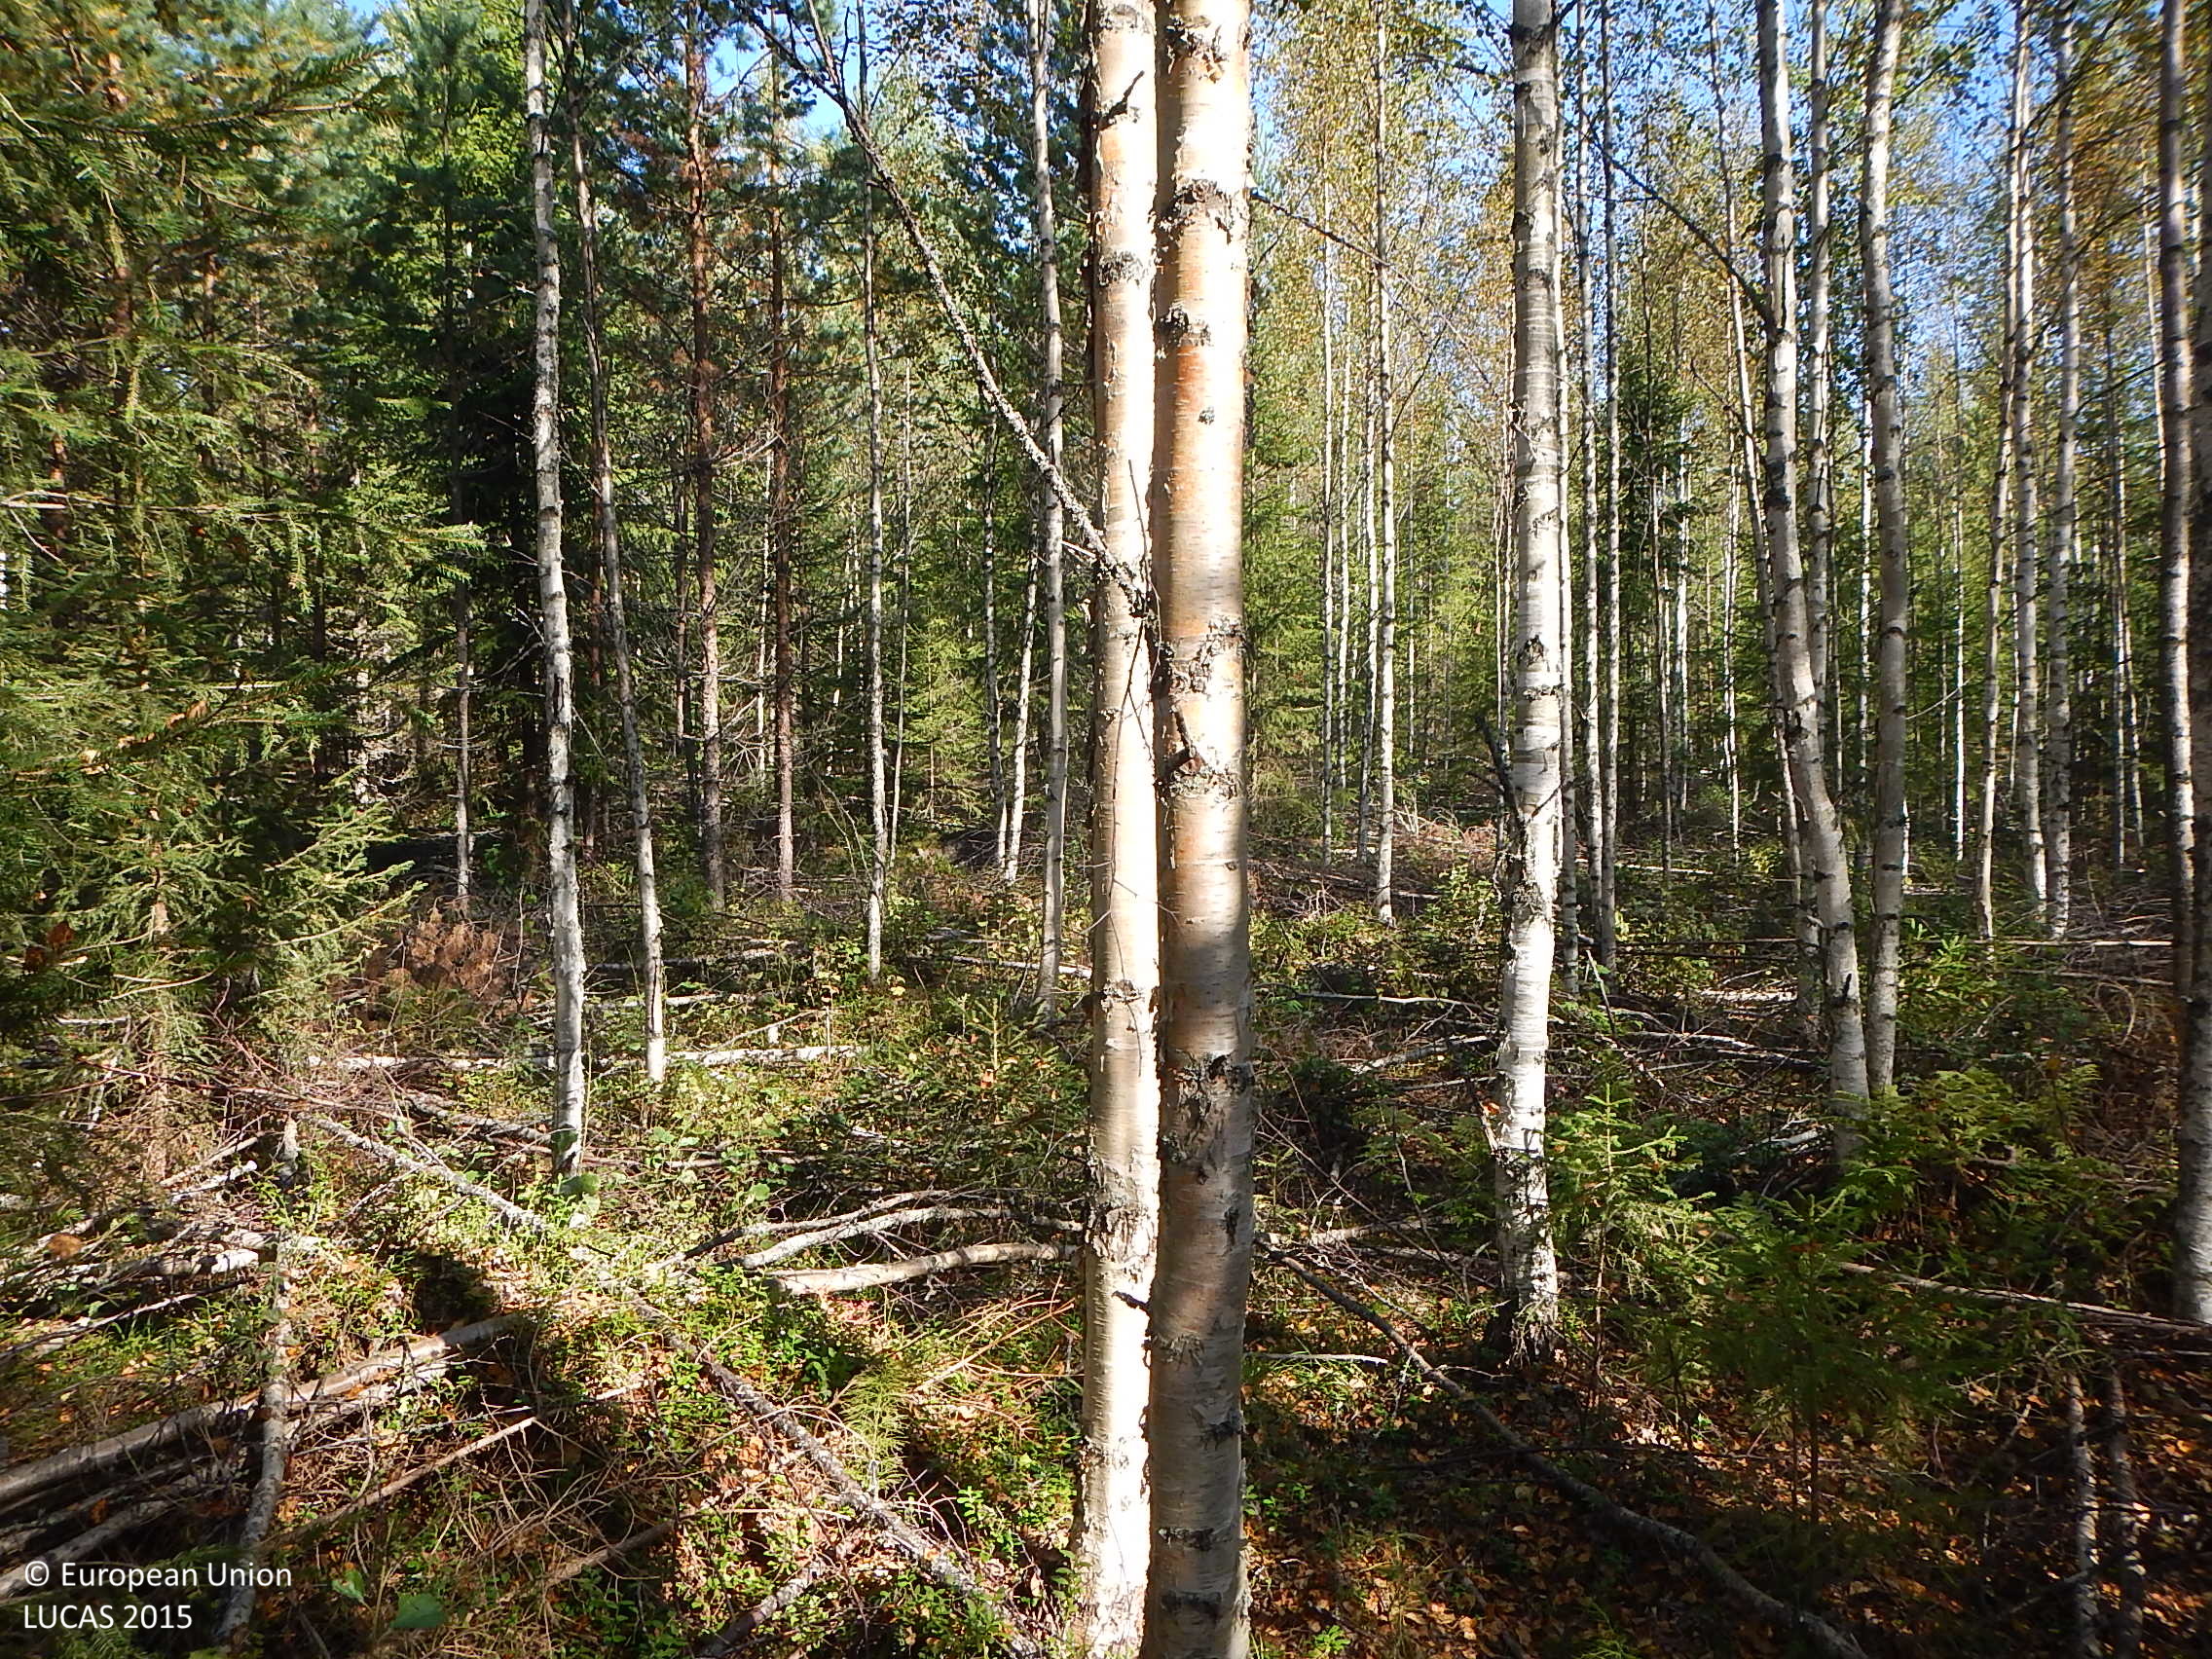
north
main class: Woodland
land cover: Broadleaved woodland
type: boreal forest
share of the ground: 50 - 75 %
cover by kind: broadleaved forest trees 60 %, herbaceous plants 15 %, coniferous forest trees 10 %, lichens and mosses 5 %, unconsolidated bare surface 5 %
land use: Forestry
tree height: > 5 m
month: September
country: FI
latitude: 61.5166
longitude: 22.5641
